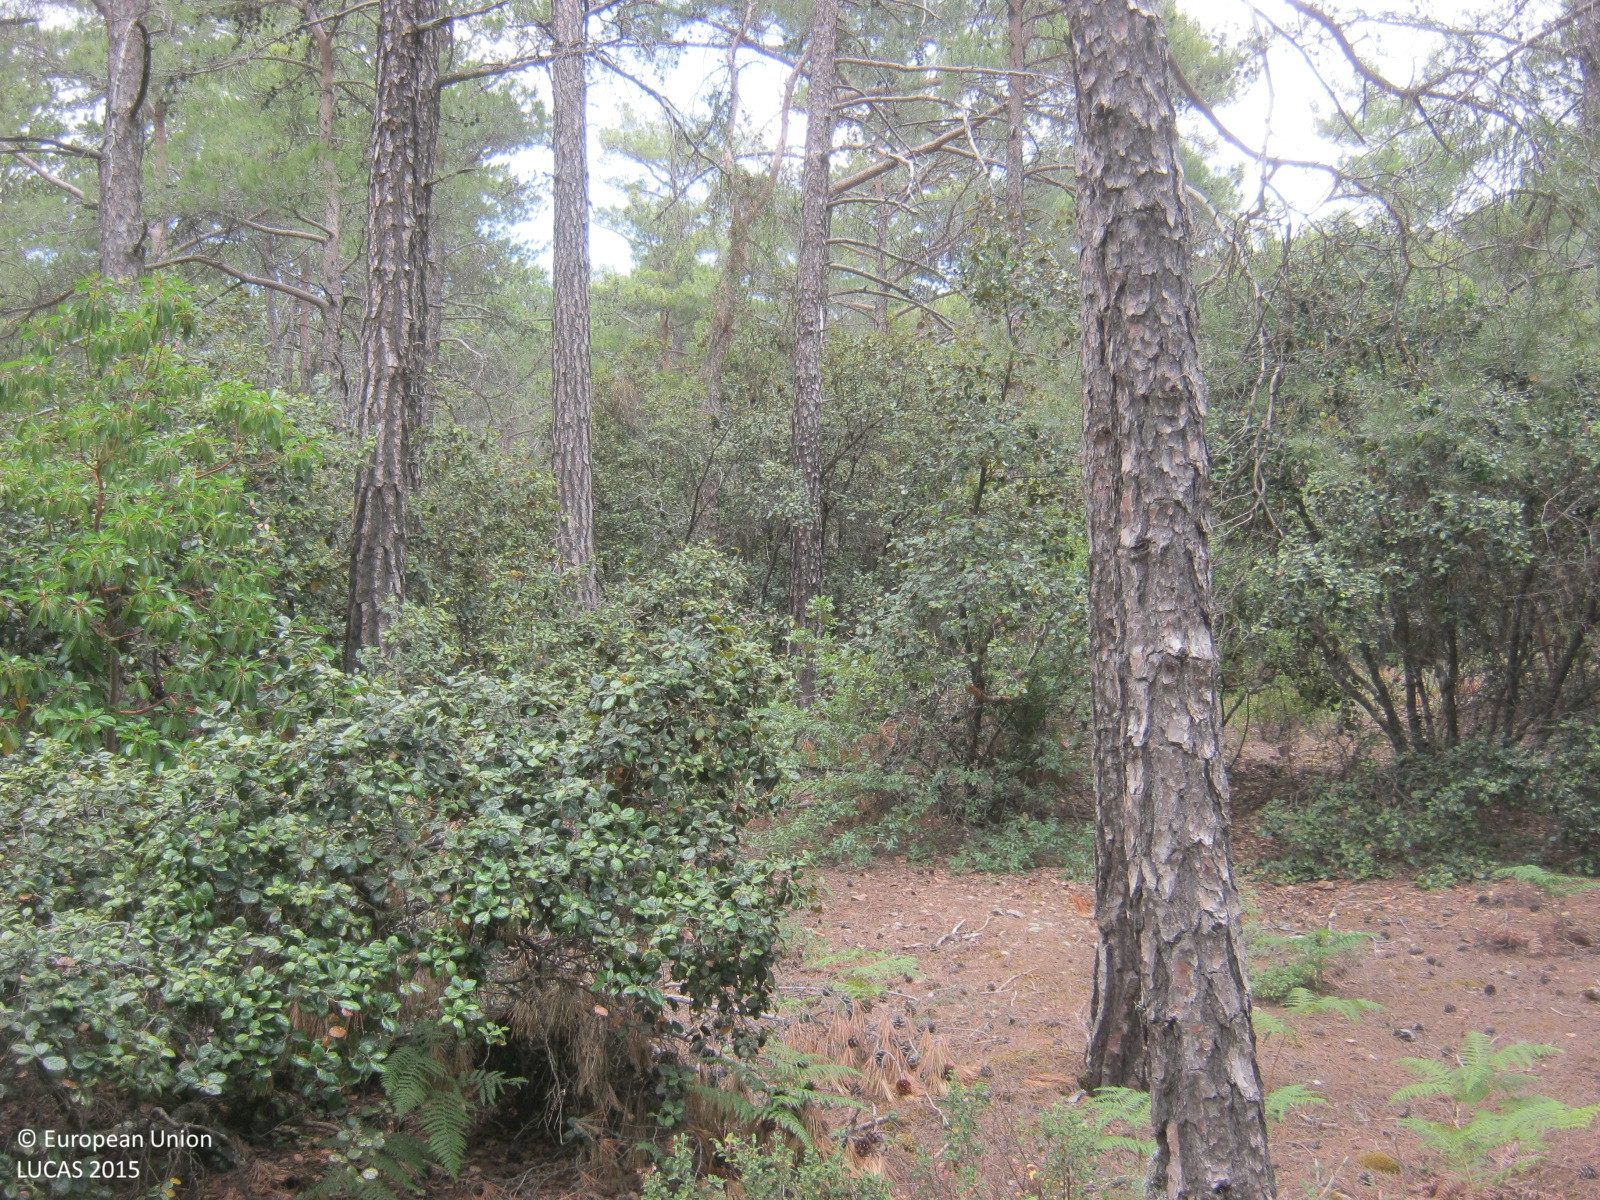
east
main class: Woodland
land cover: Pine dominated mixed woodland
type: coniferous forest of the mediterranean region
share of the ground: > 75 %
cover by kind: coniferous forest trees 60 %, broadleaved forest trees 30 %, shrubs 10 %
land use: Forestry
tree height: > 5 m
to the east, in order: Pine dominated mixed woodland; Paved roads, cycling and walking lanes; Pine dominated mixed woodland; Tracks; Pine dominated mixed woodland
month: June
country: CY
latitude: 34.9639
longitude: 32.8483
